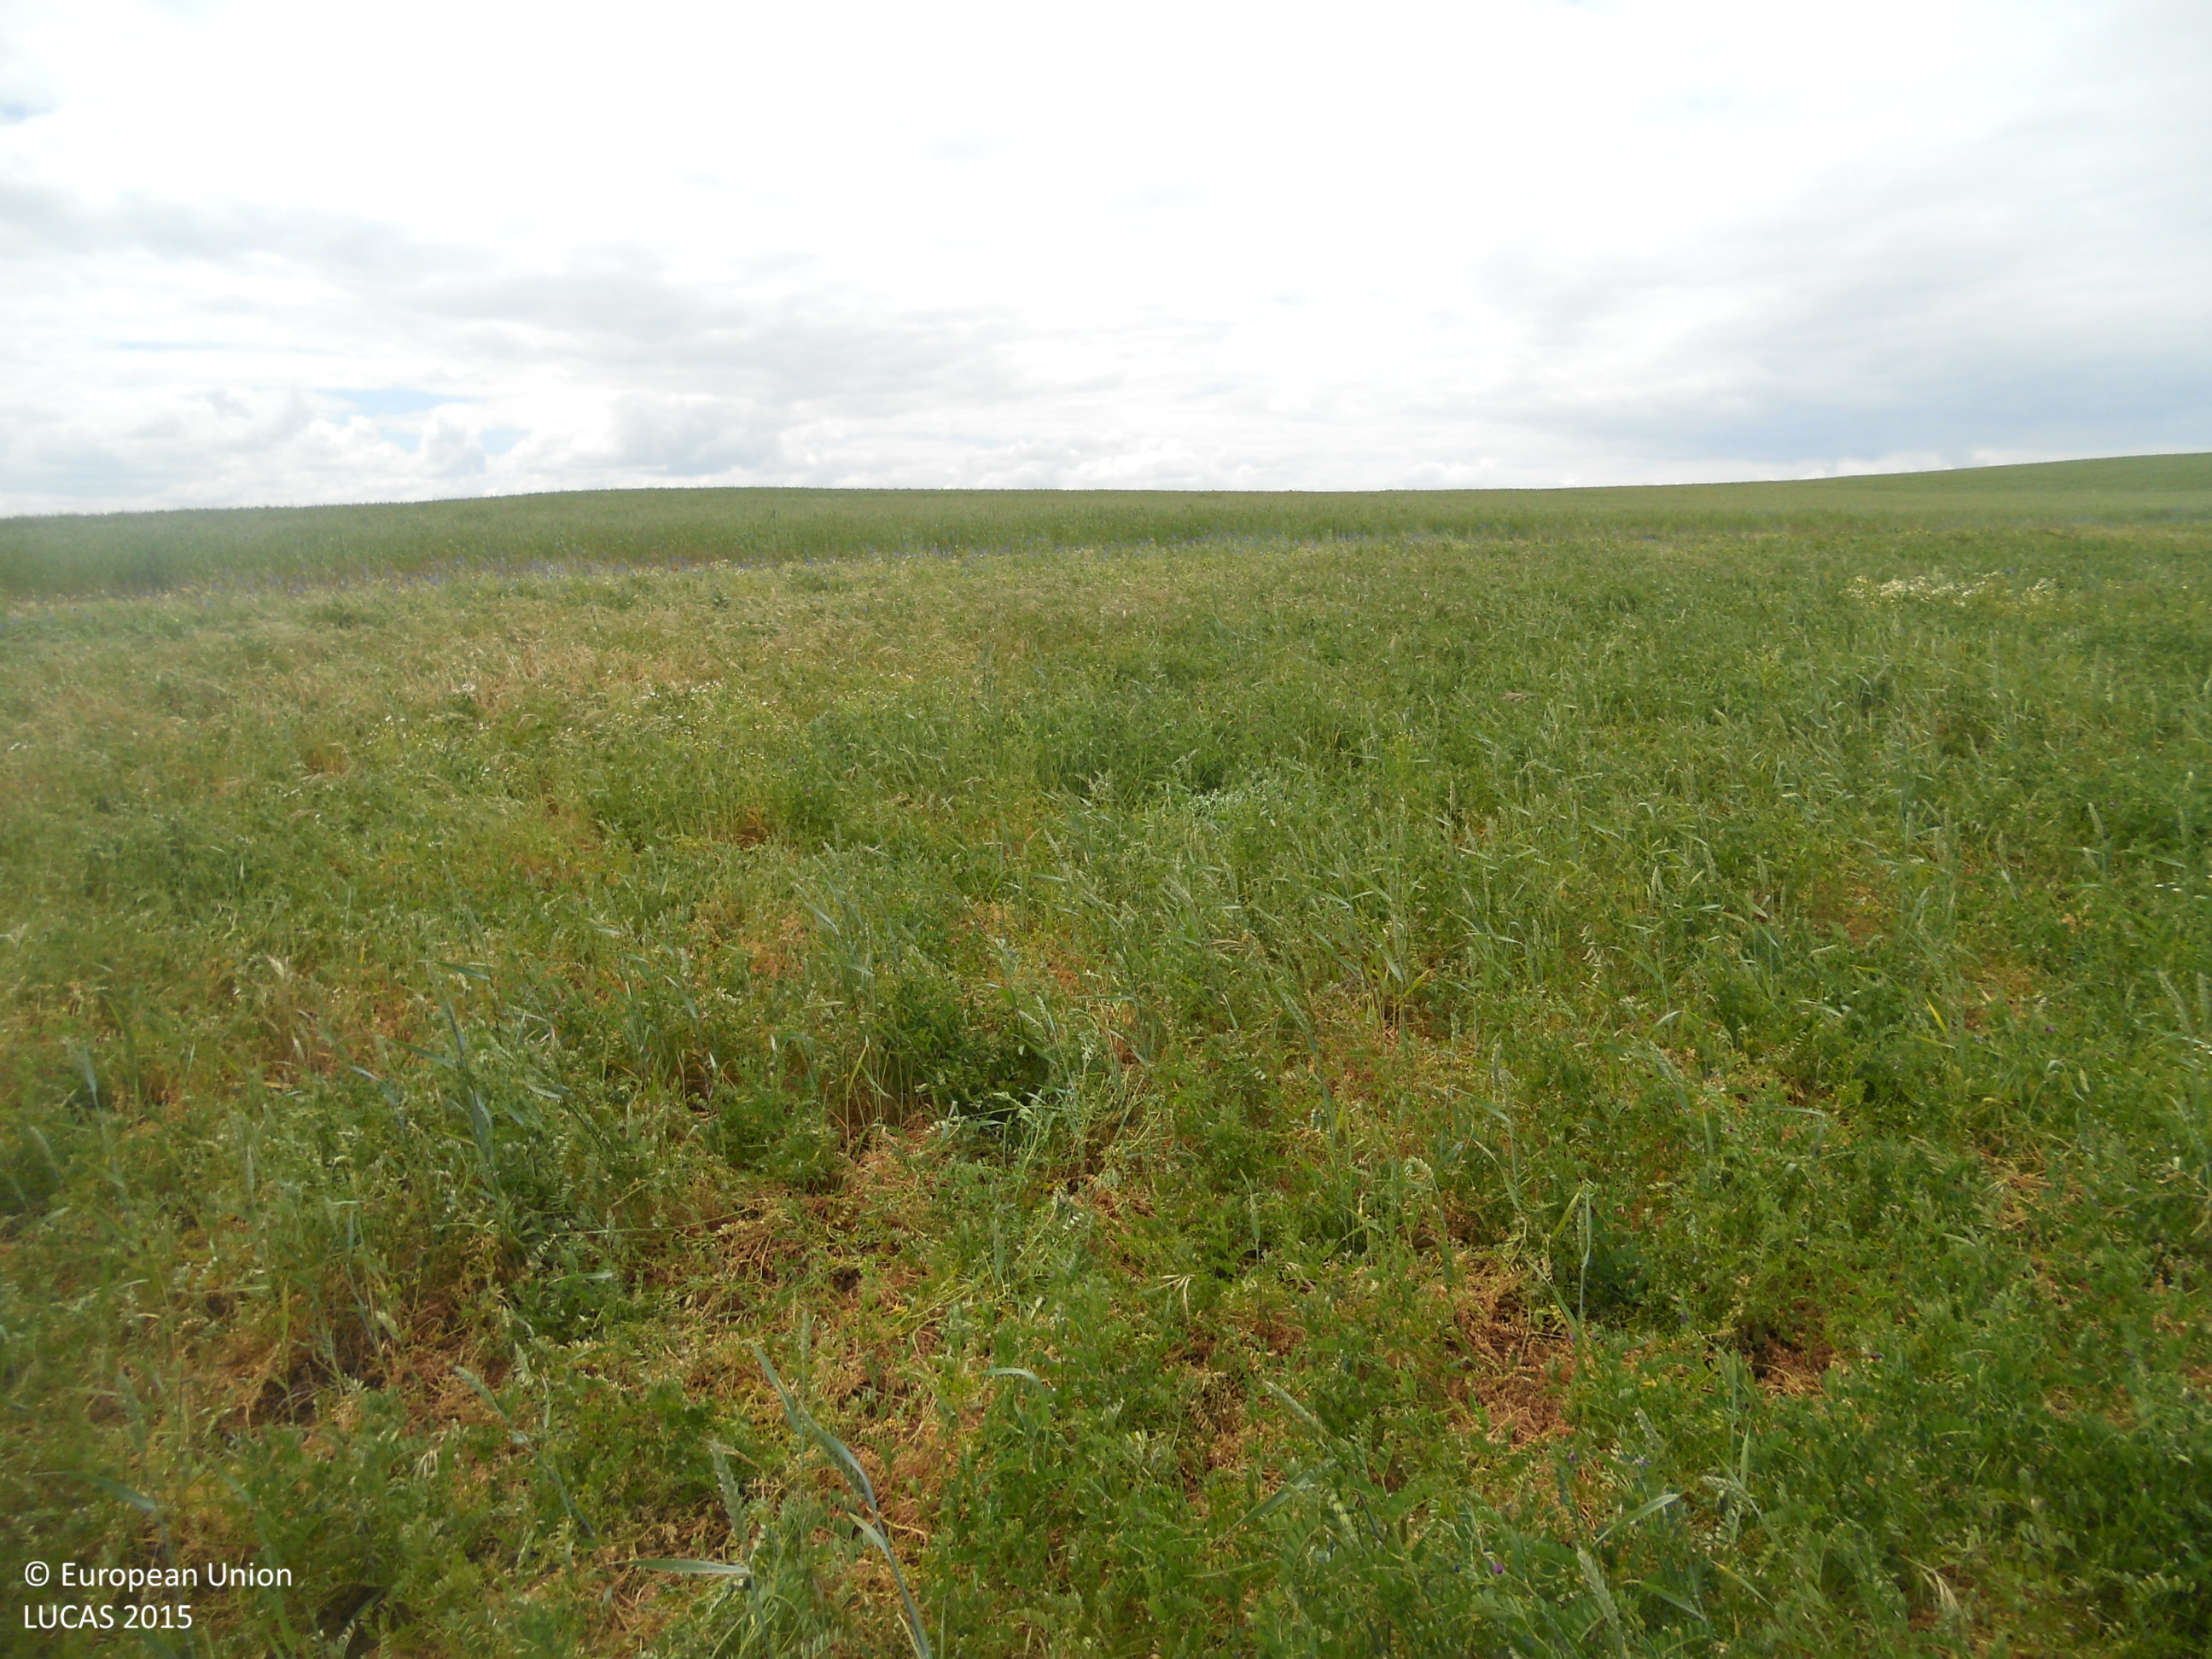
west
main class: Cropland
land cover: Dry pulses
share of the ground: > 75 %
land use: Agriculture (excluding fallow land and kitchen gardens)
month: May
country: ES
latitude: 42.4632
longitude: -4.3870
